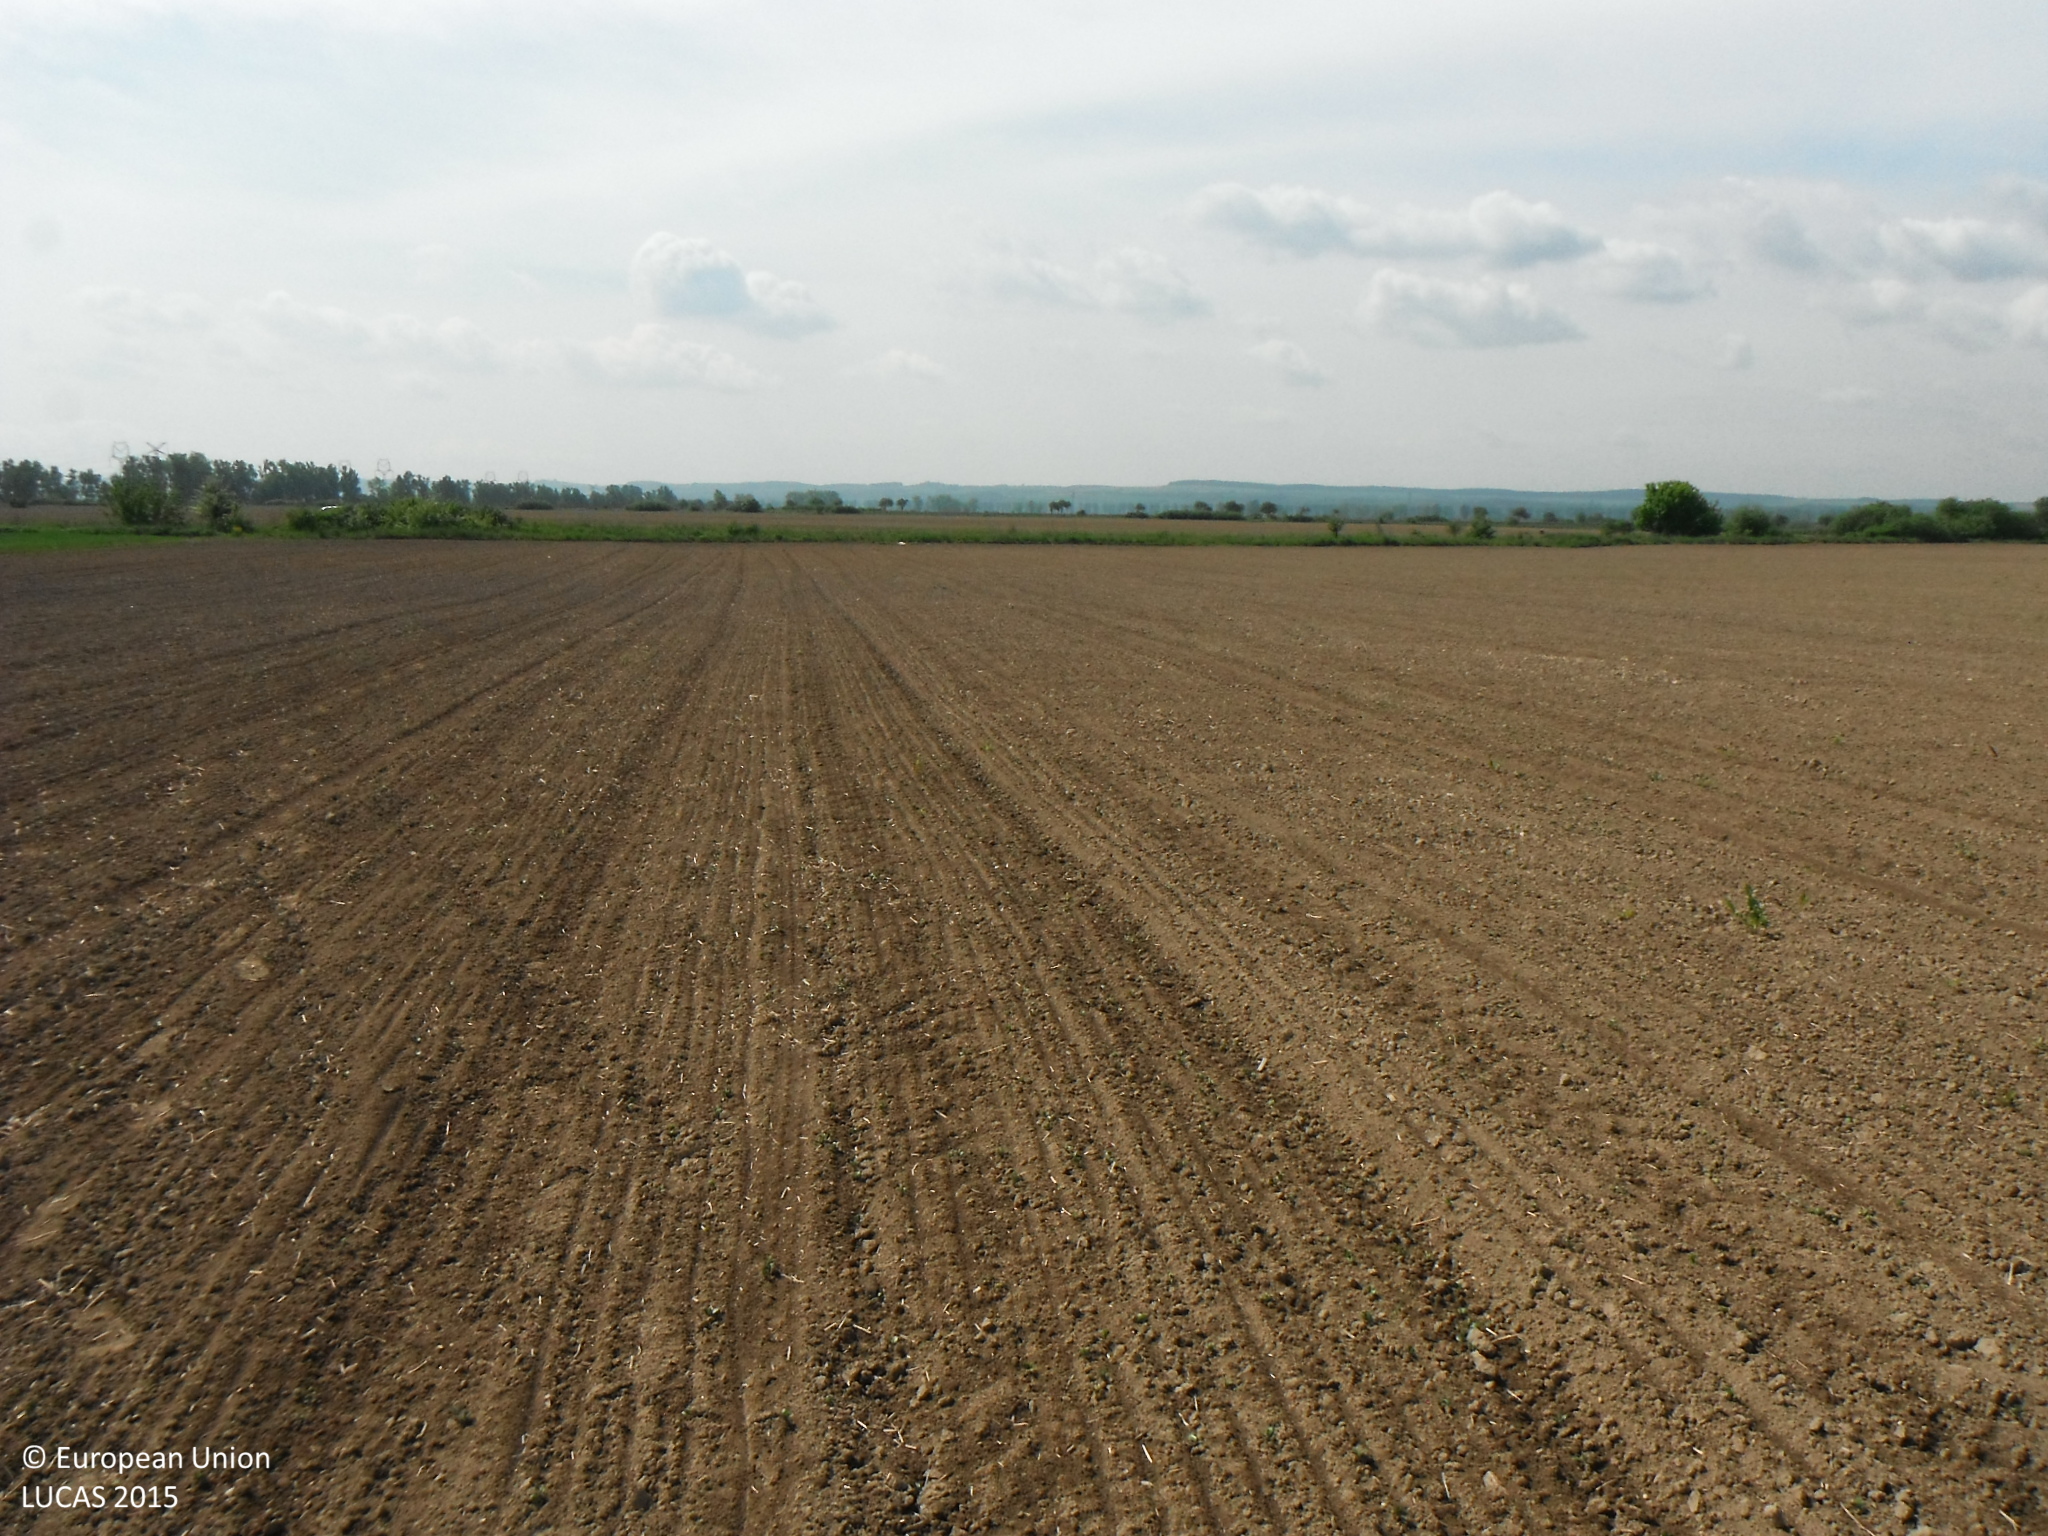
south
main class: Cropland
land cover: Soya
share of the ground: < 10 %
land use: Agriculture (excluding fallow land and kitchen gardens)
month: May
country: SK
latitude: 48.5936
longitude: 21.0375
